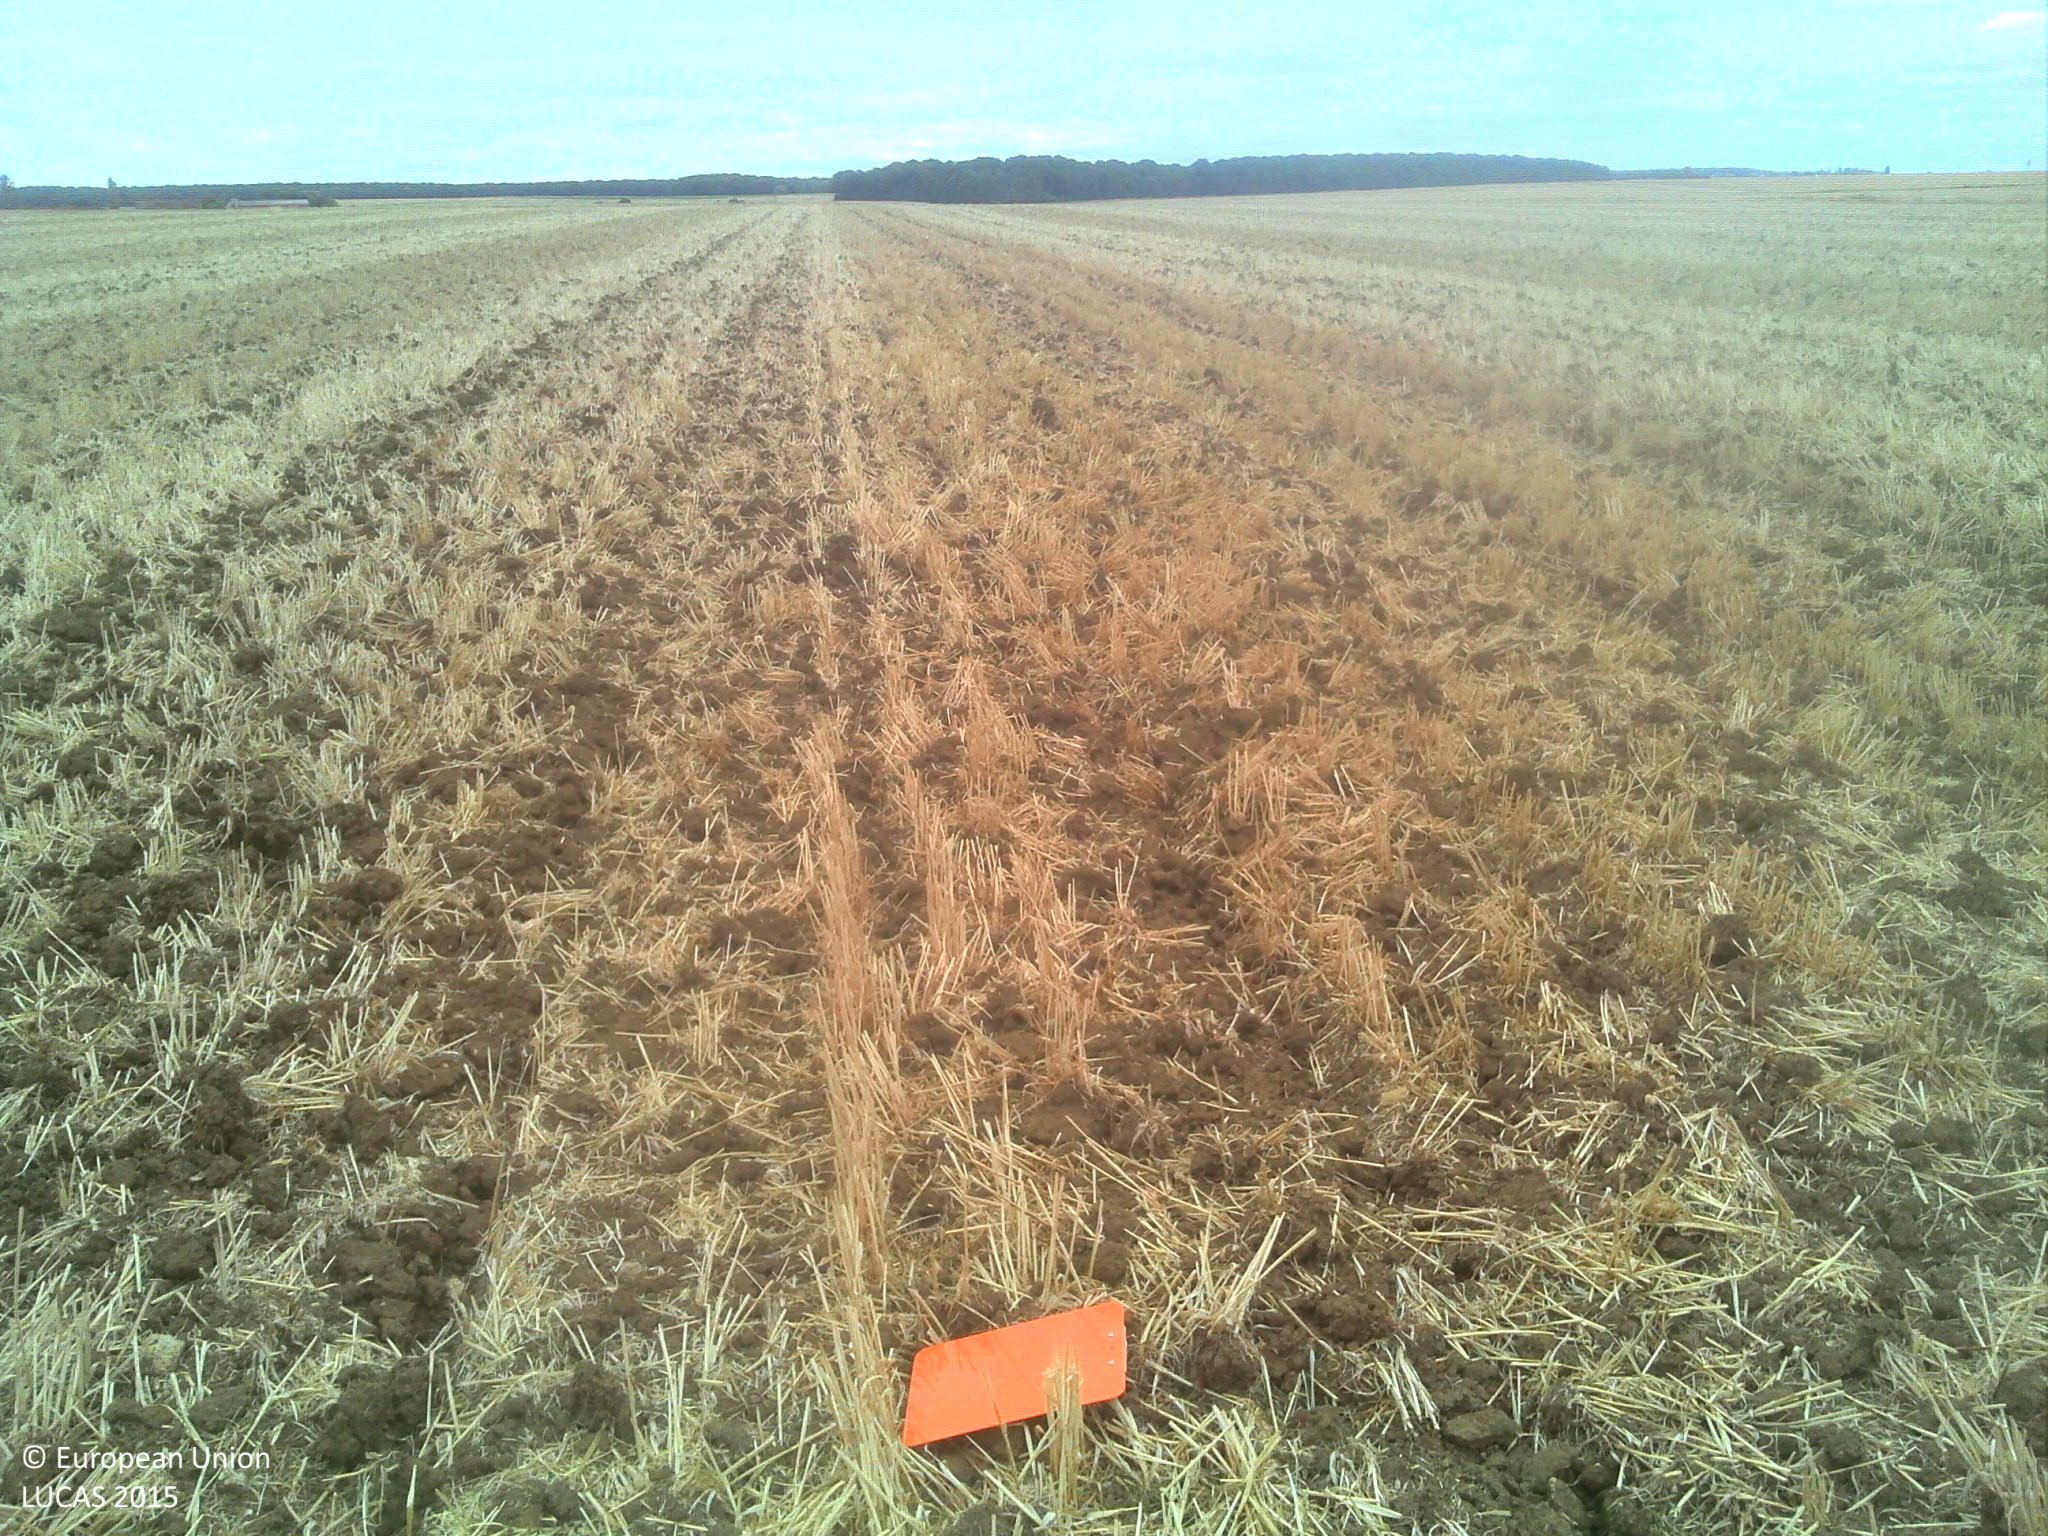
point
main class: Cropland
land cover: Common wheat
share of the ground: > 75 %
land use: Agriculture (excluding fallow land and kitchen gardens)
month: July
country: FR
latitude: 47.8438
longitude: 1.3115
